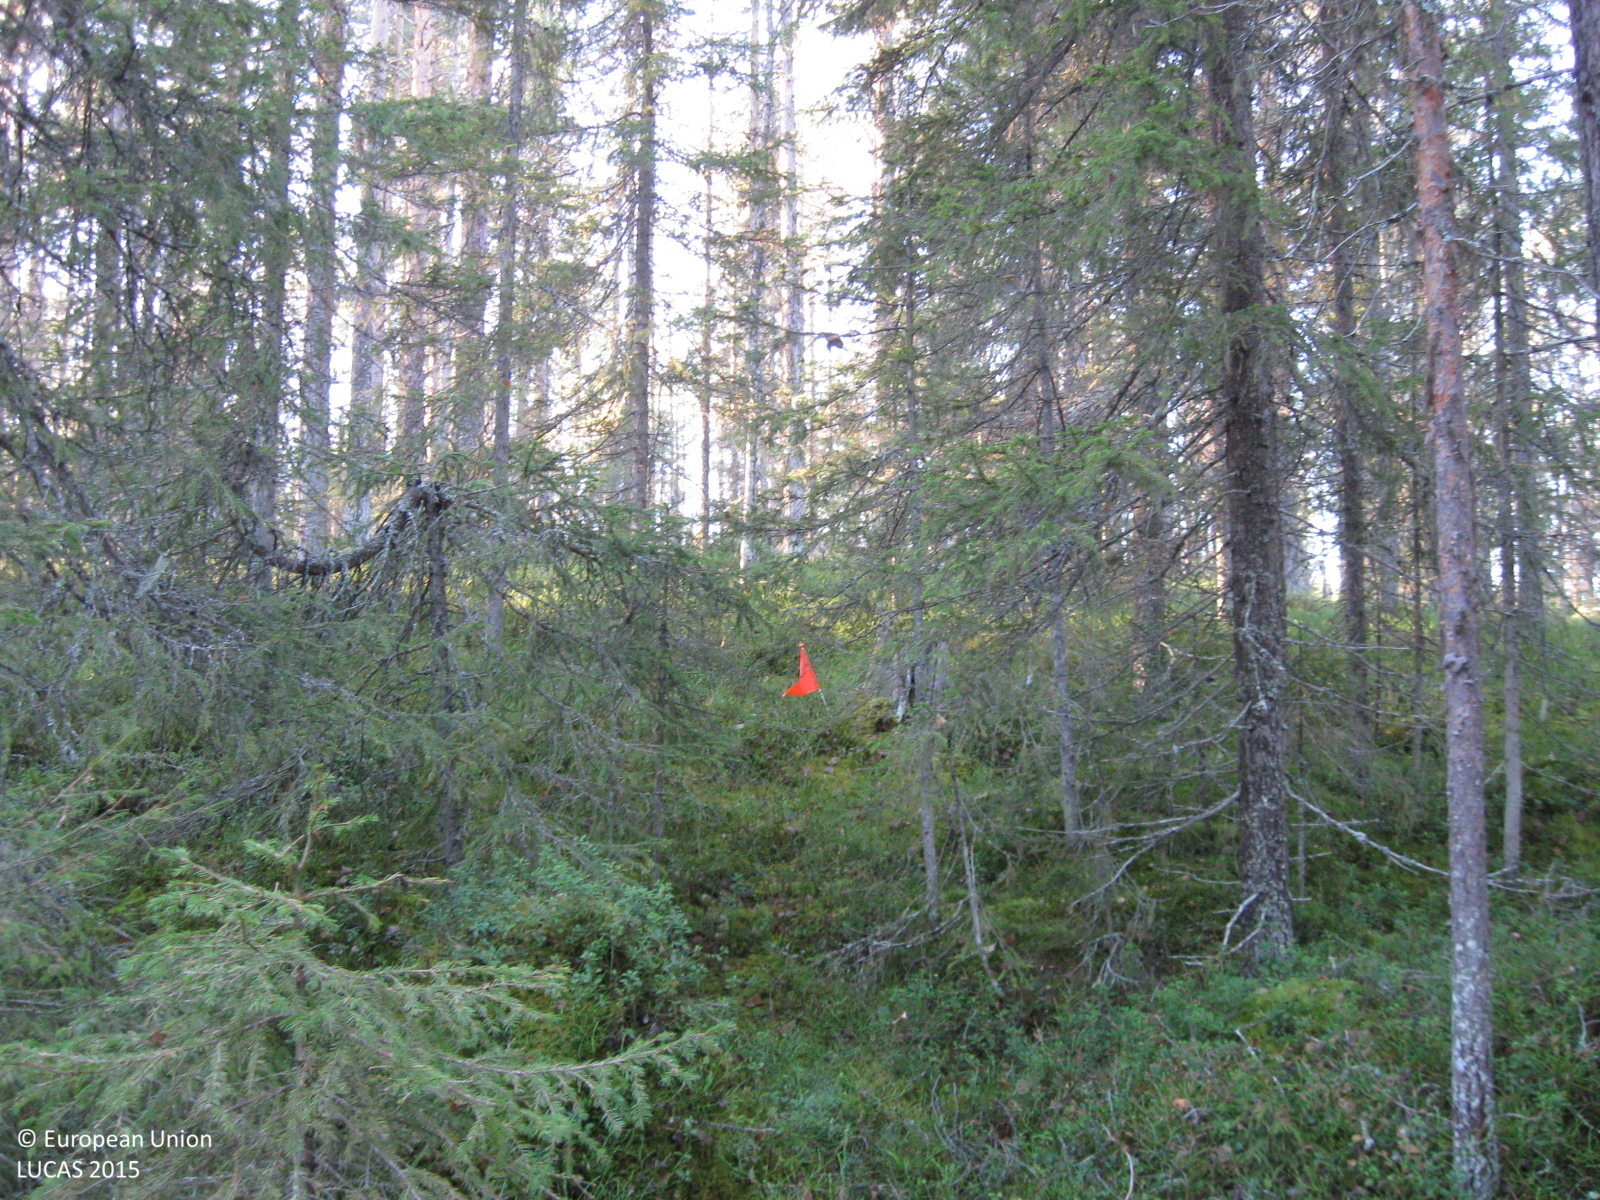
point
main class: Woodland
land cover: Other coniferous woodland
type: boreal forest
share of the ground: > 75 %
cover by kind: coniferous forest trees 80 %, broadleaved forest trees 5 %, shrubs 5 %, herbaceous plants 5 %, lichens and mosses 5 %
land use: Forestry
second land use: Amenities, museums, leisure
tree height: > 5 m
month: November
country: SE
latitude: 66.1340
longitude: 20.7485
